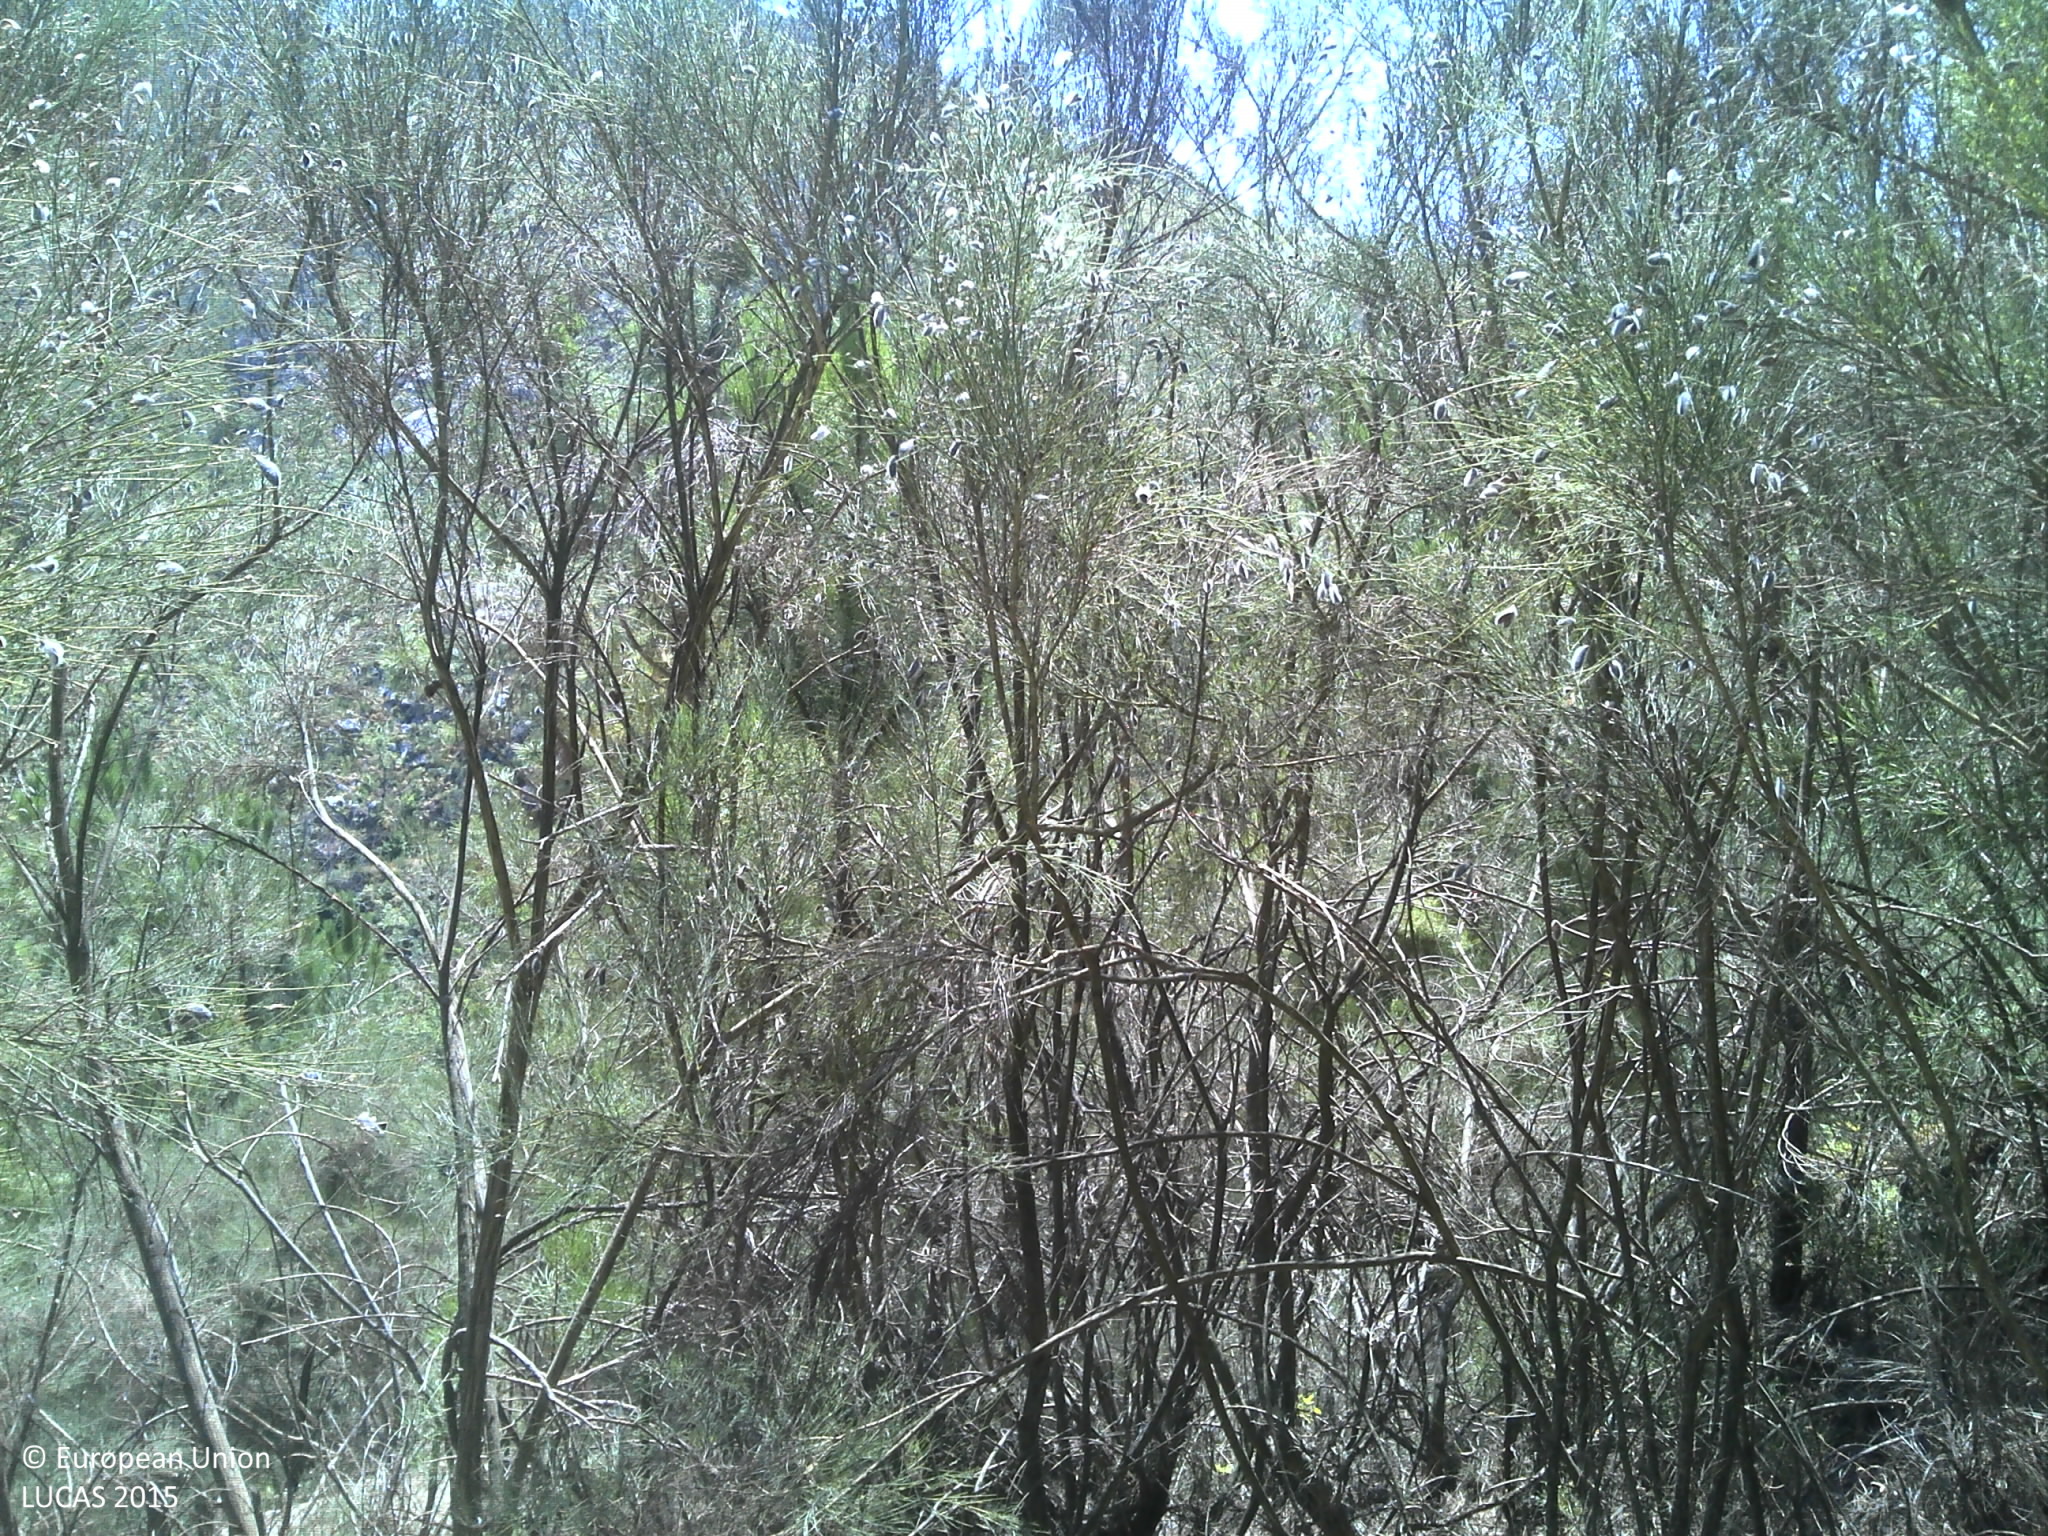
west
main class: Shrubland
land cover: Shrubland with sparse tree cover
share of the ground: 50 - 75 %
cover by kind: shrubs 75 %, unconsolidated bare surface 20 %, coniferous forest trees 5 %
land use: Abandoned areas
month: July
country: PT
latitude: 40.3751
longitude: -7.7226
